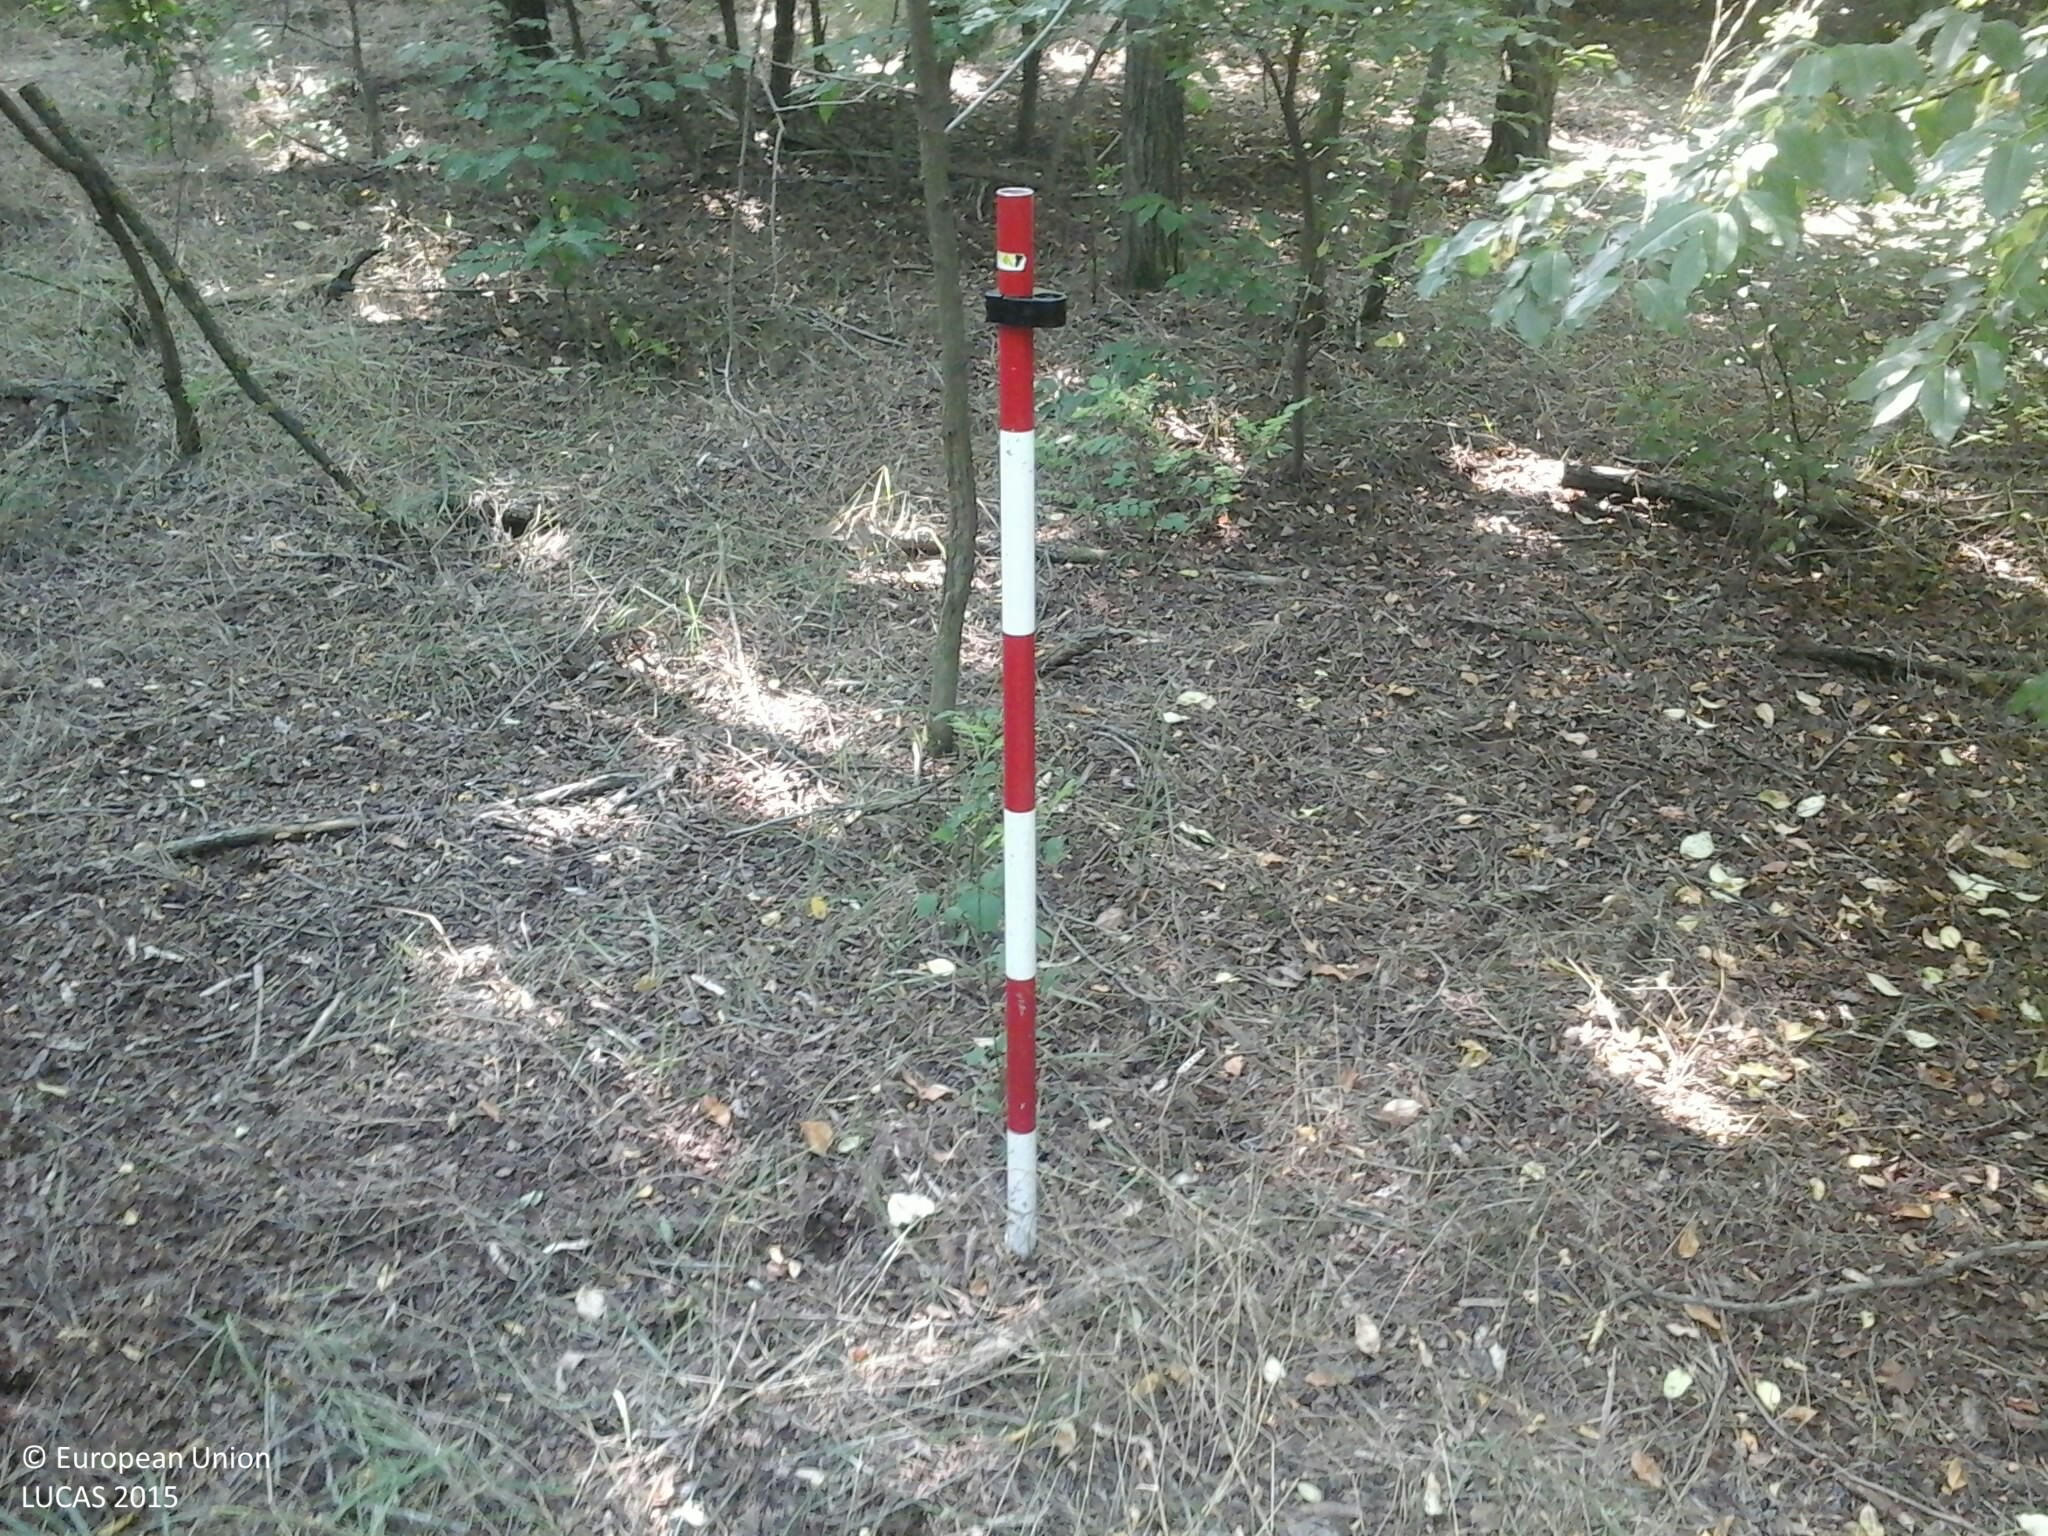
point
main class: Woodland
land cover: Broadleaved woodland
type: mesophytic deciduous forest
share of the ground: 25 - 50 %
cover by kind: broadleaved forest trees 95 %, herbaceous plants 5 %
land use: Forestry
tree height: > 5 m
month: July
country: HU
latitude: 47.6892
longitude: 21.8662
